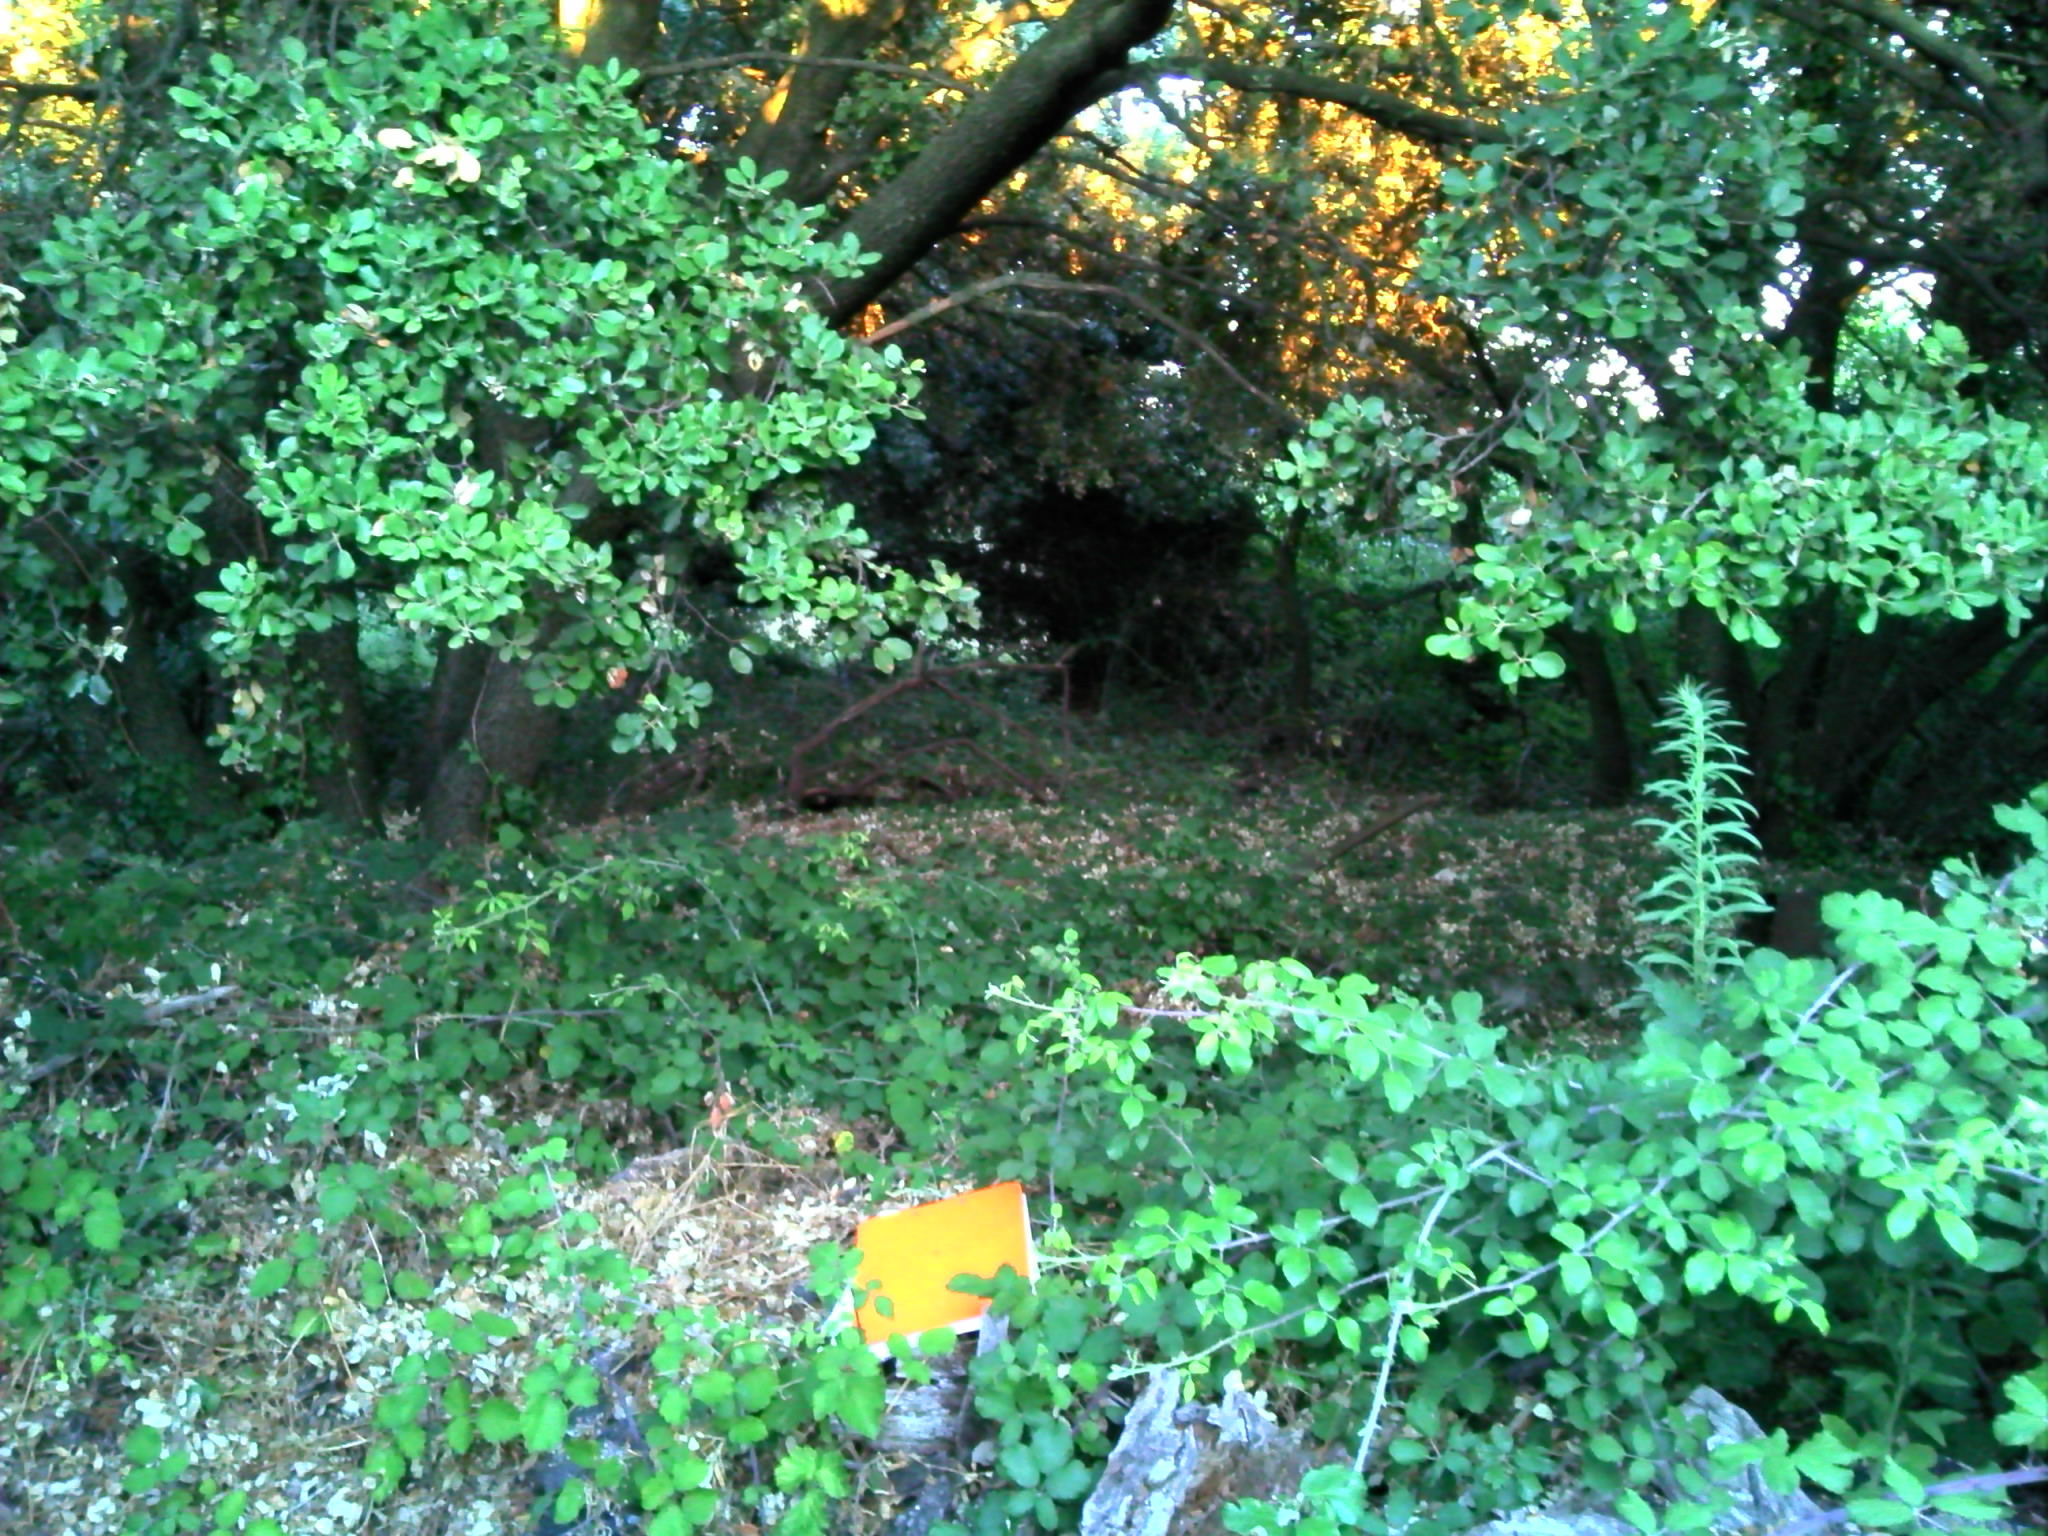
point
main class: Woodland
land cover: Broadleaved woodland
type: broadleaved evergreen forest
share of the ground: > 75 %
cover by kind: broadleaved forest trees 70 %, herbaceous plants 15 %, consolidated bare surface 15 %
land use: Forestry
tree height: > 5 m
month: August
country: FR
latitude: 43.9601
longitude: 4.6621
